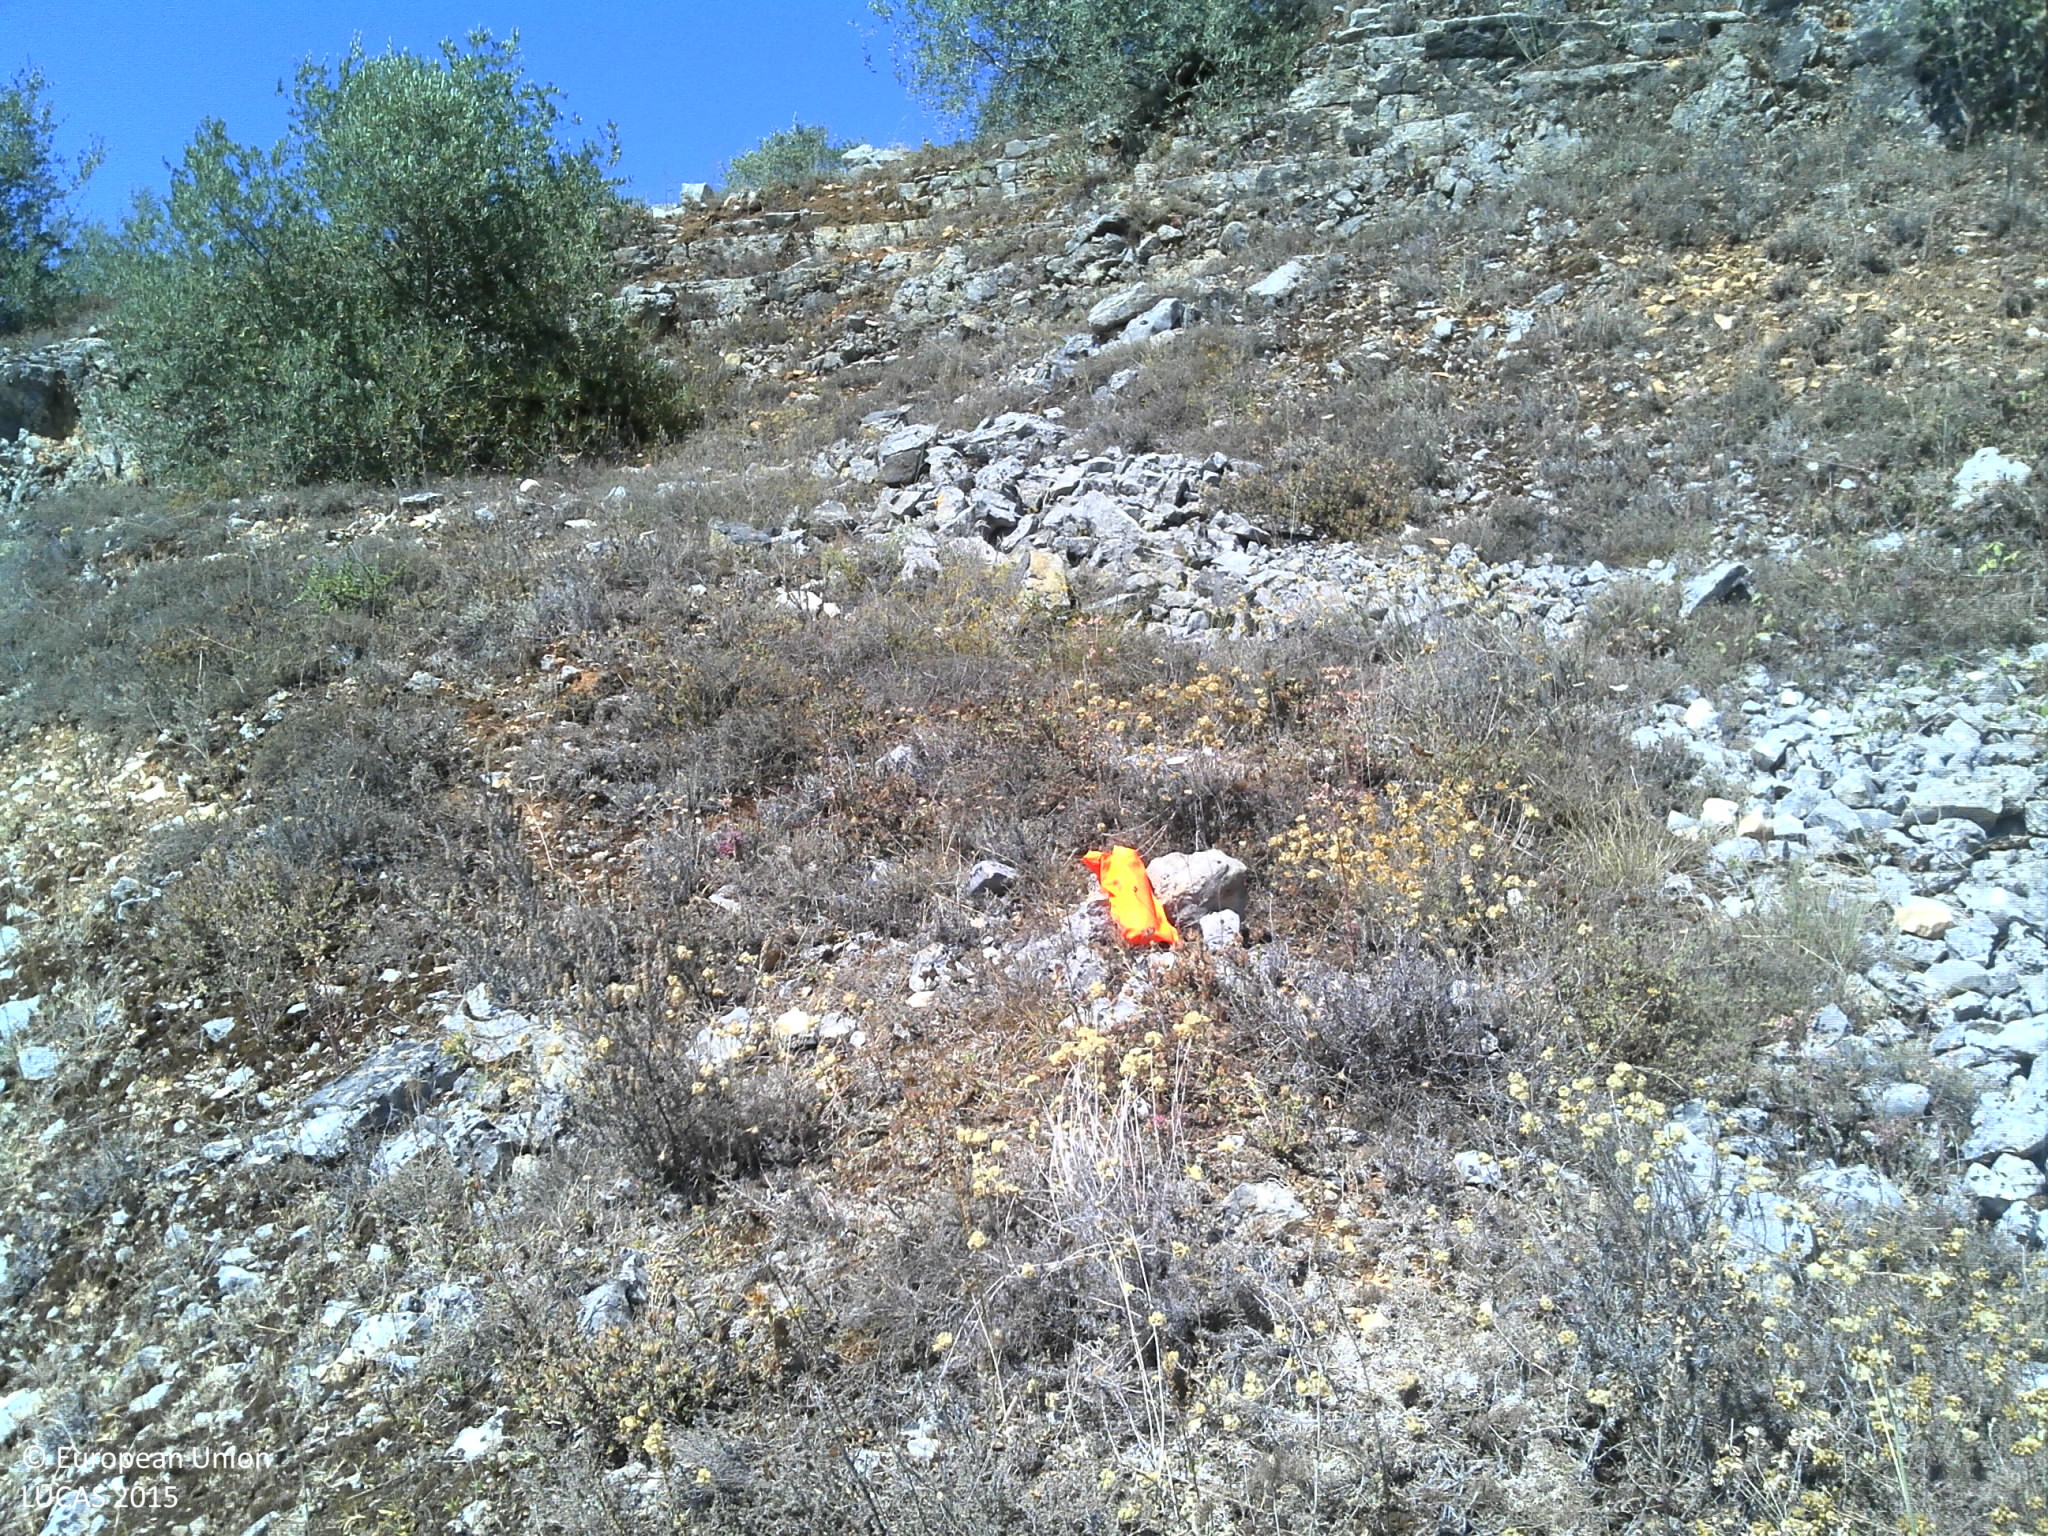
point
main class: Grassland
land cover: Grassland with sparse tree/shrub cover
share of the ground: 25 - 50 %
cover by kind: herbaceous plants 50 %, unconsolidated bare surface 25 %, broadleaved forest trees 5 %
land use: Abandoned areas
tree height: < 5 m
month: July
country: PT
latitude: 40.0190
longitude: -8.5367
